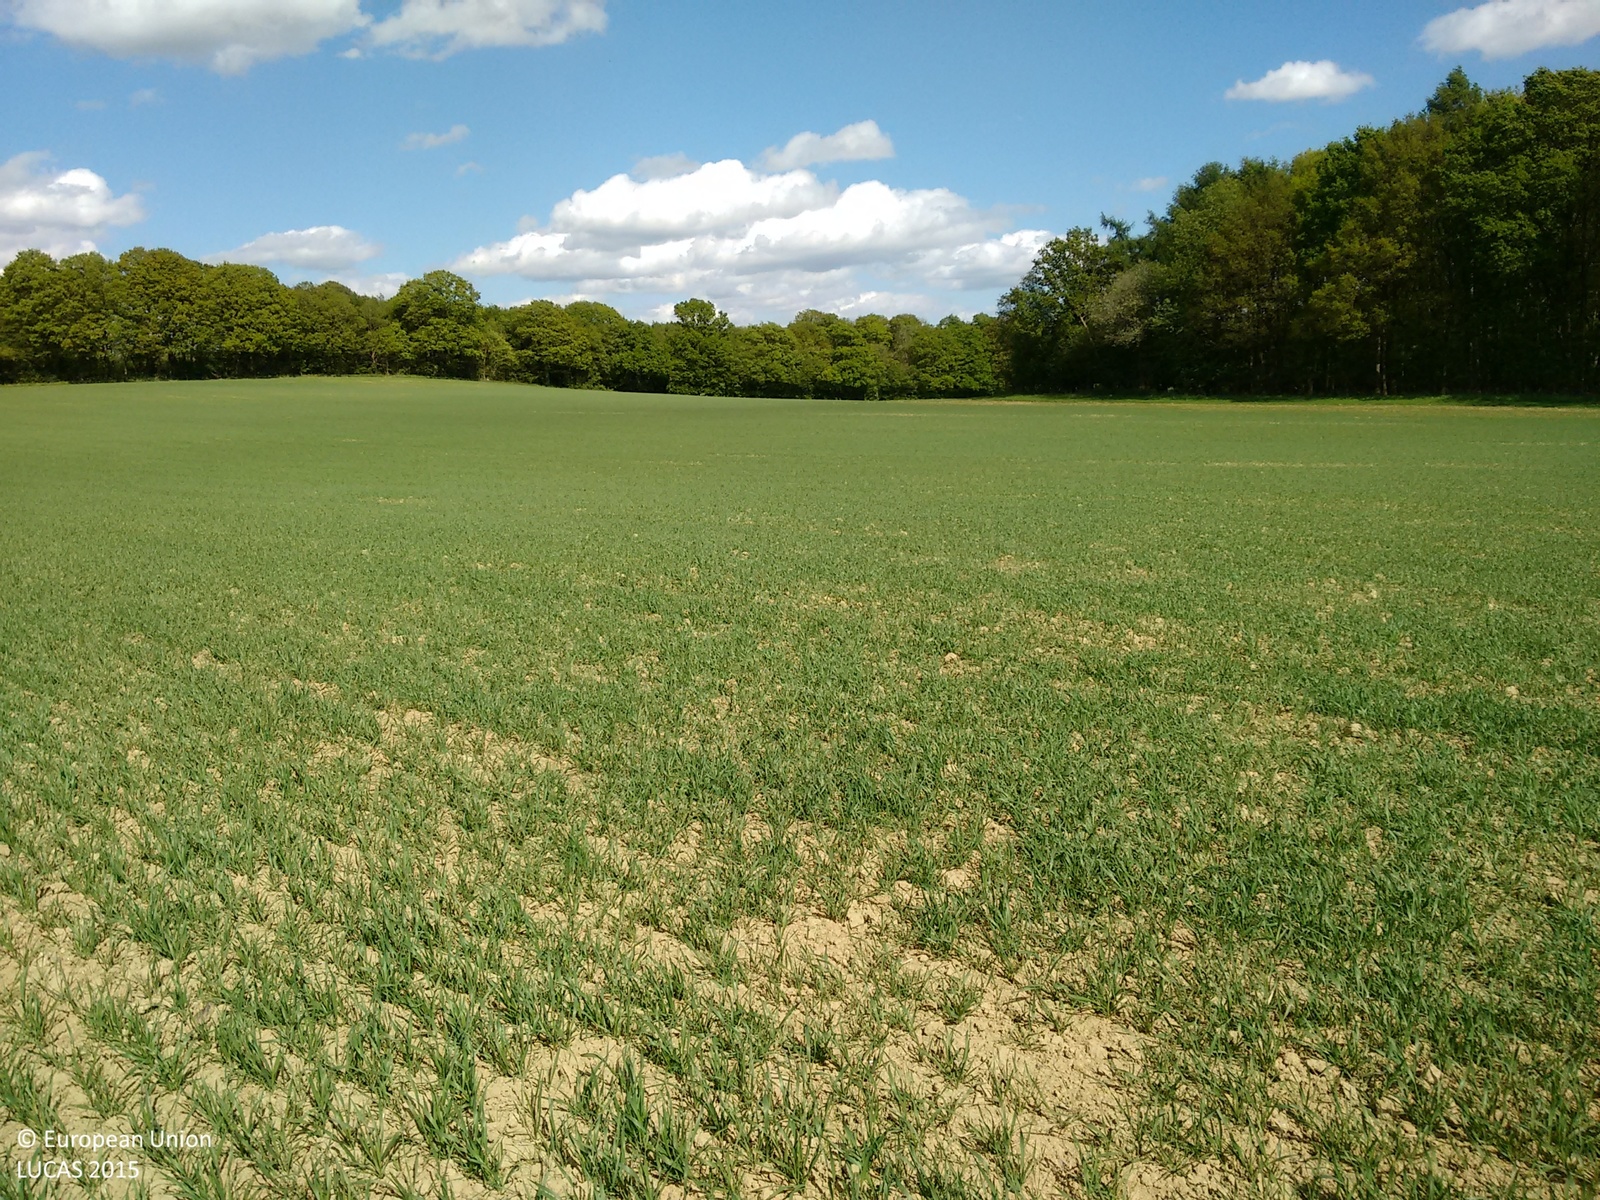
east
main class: Cropland
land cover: Common wheat
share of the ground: 25 - 50 %
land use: Agriculture (excluding fallow land and kitchen gardens)
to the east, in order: Common wheat
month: May
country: GB
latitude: 51.2370
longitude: 0.3022
